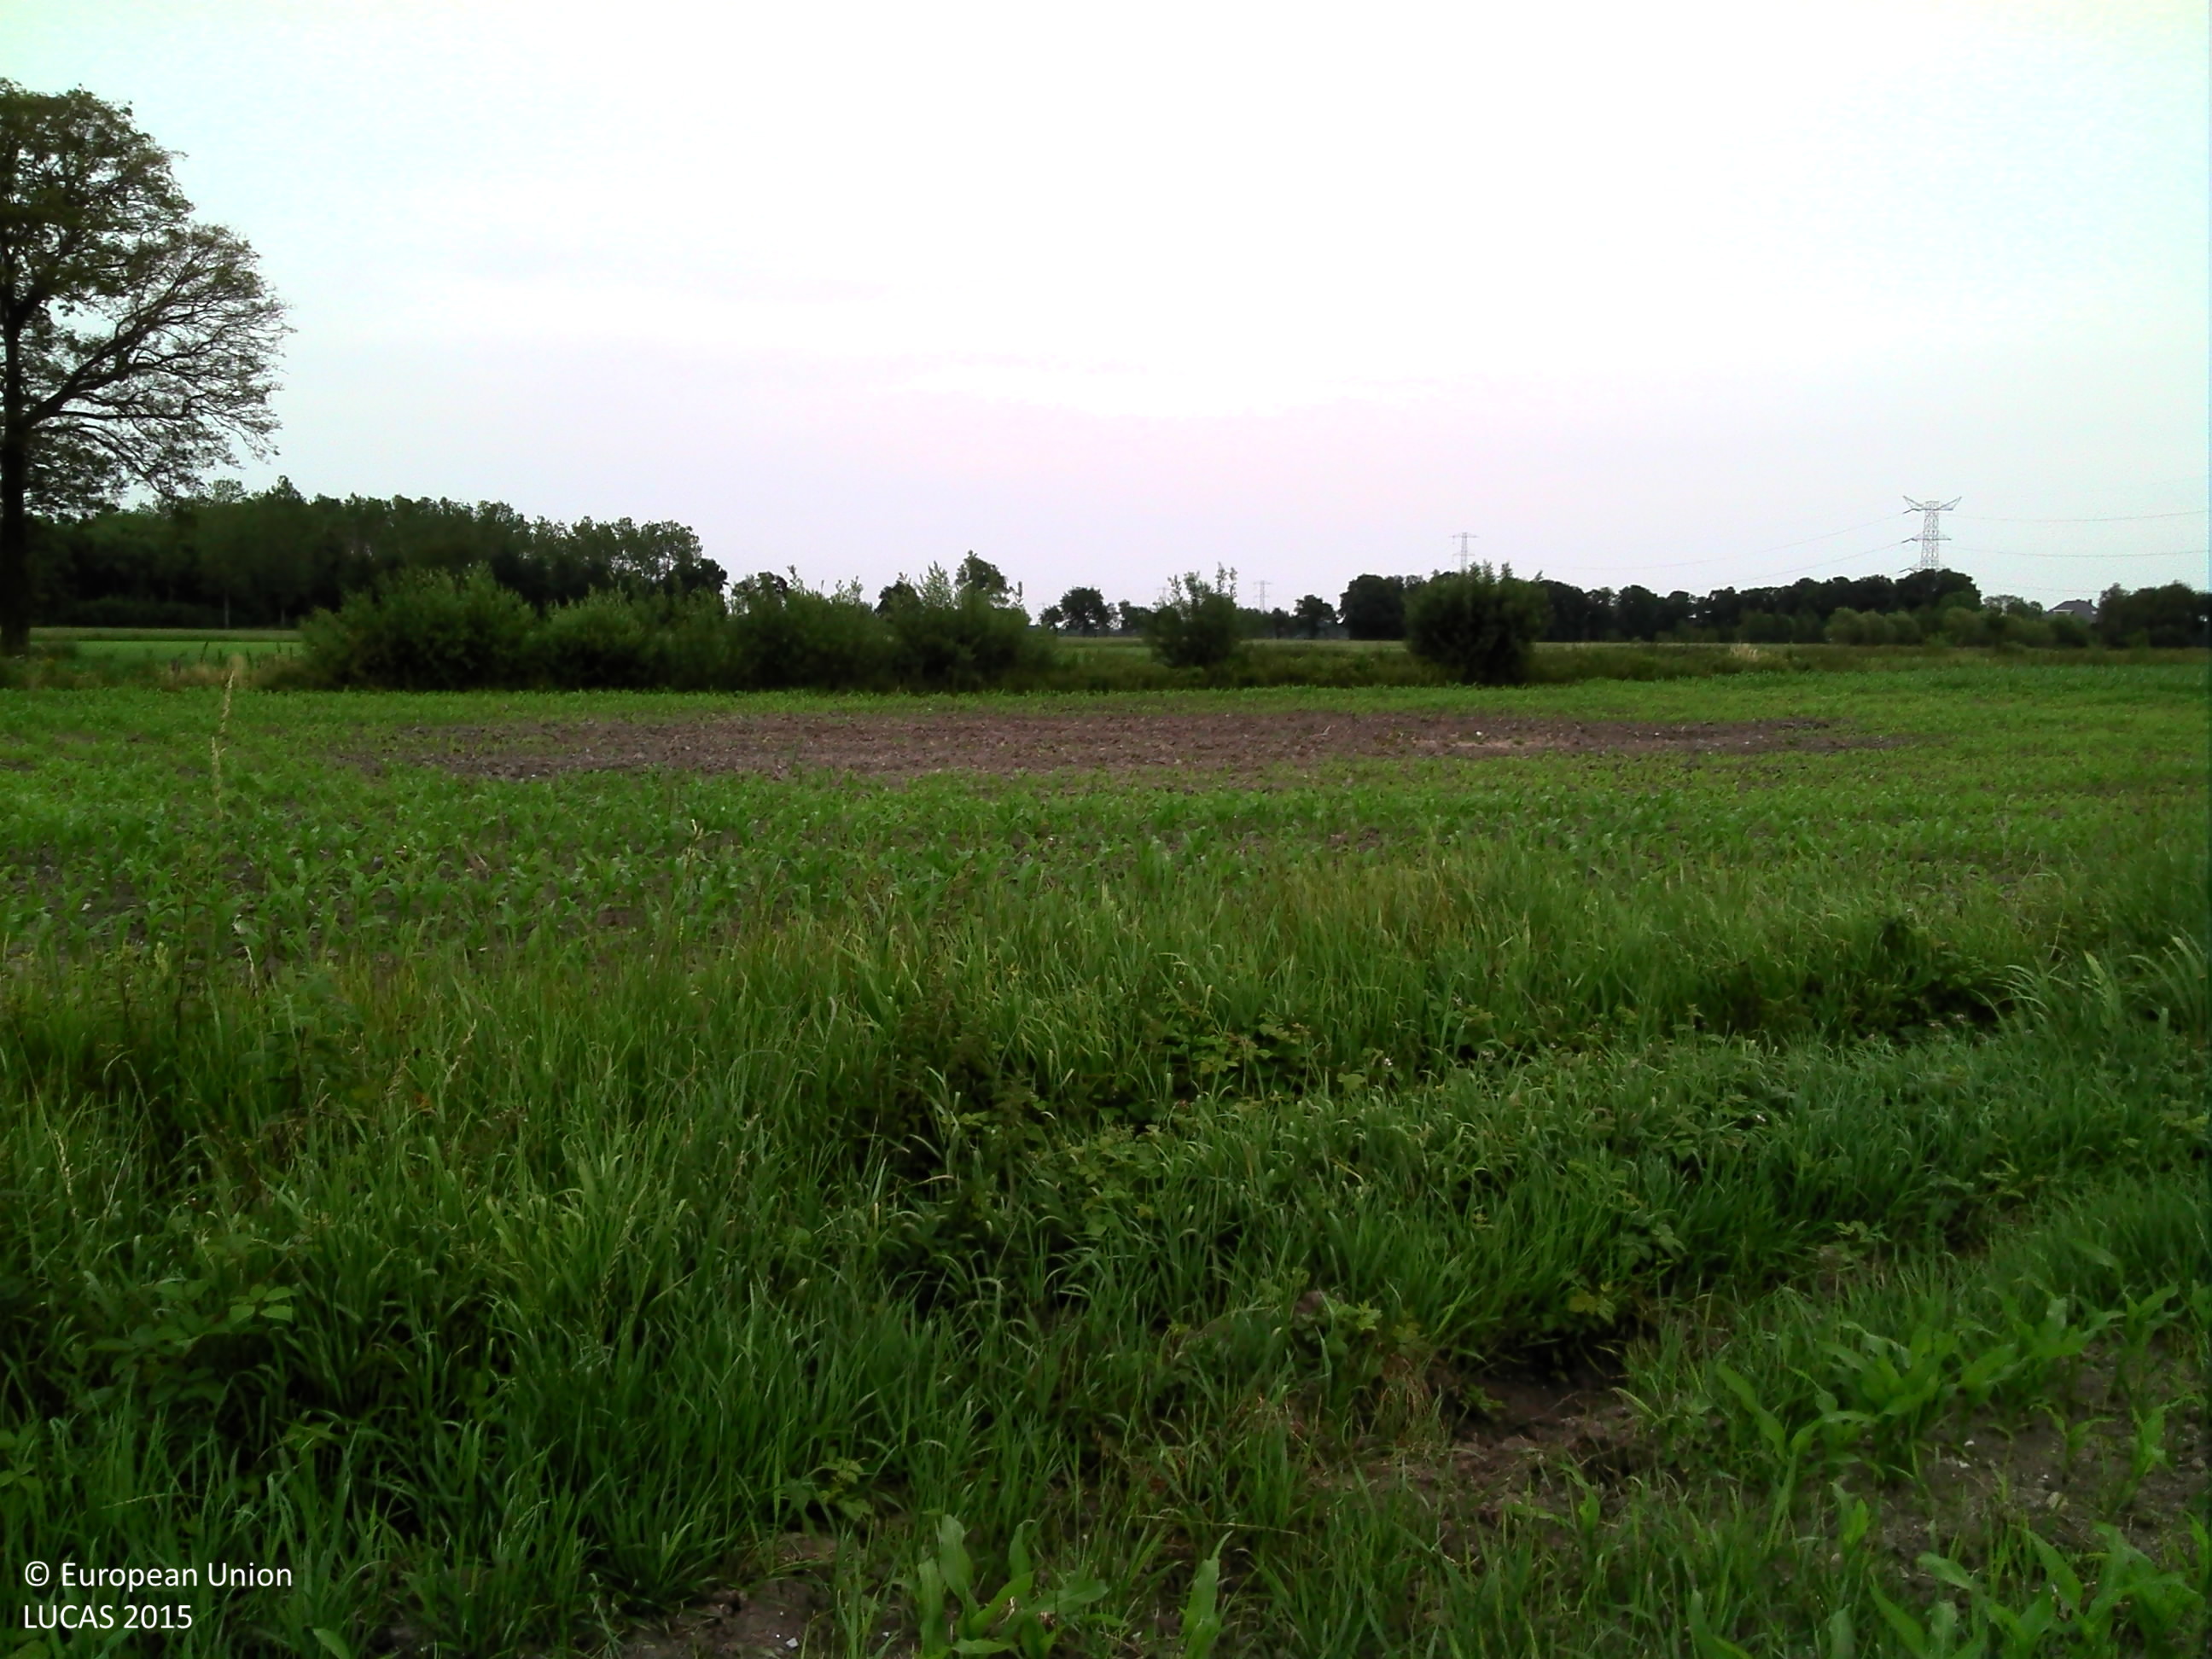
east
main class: Cropland
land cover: Maize
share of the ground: 10 - 25 %
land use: Agriculture (excluding fallow land and kitchen gardens)
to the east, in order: Maize; Grass margins; Ditches and canals; Maize; Abandoned hedges; Maize; Grass margins; Grassland without tree/shrub cover; Grass margins; Temporary grasslands
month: June
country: BE
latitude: 51.1463
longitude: 5.6671
